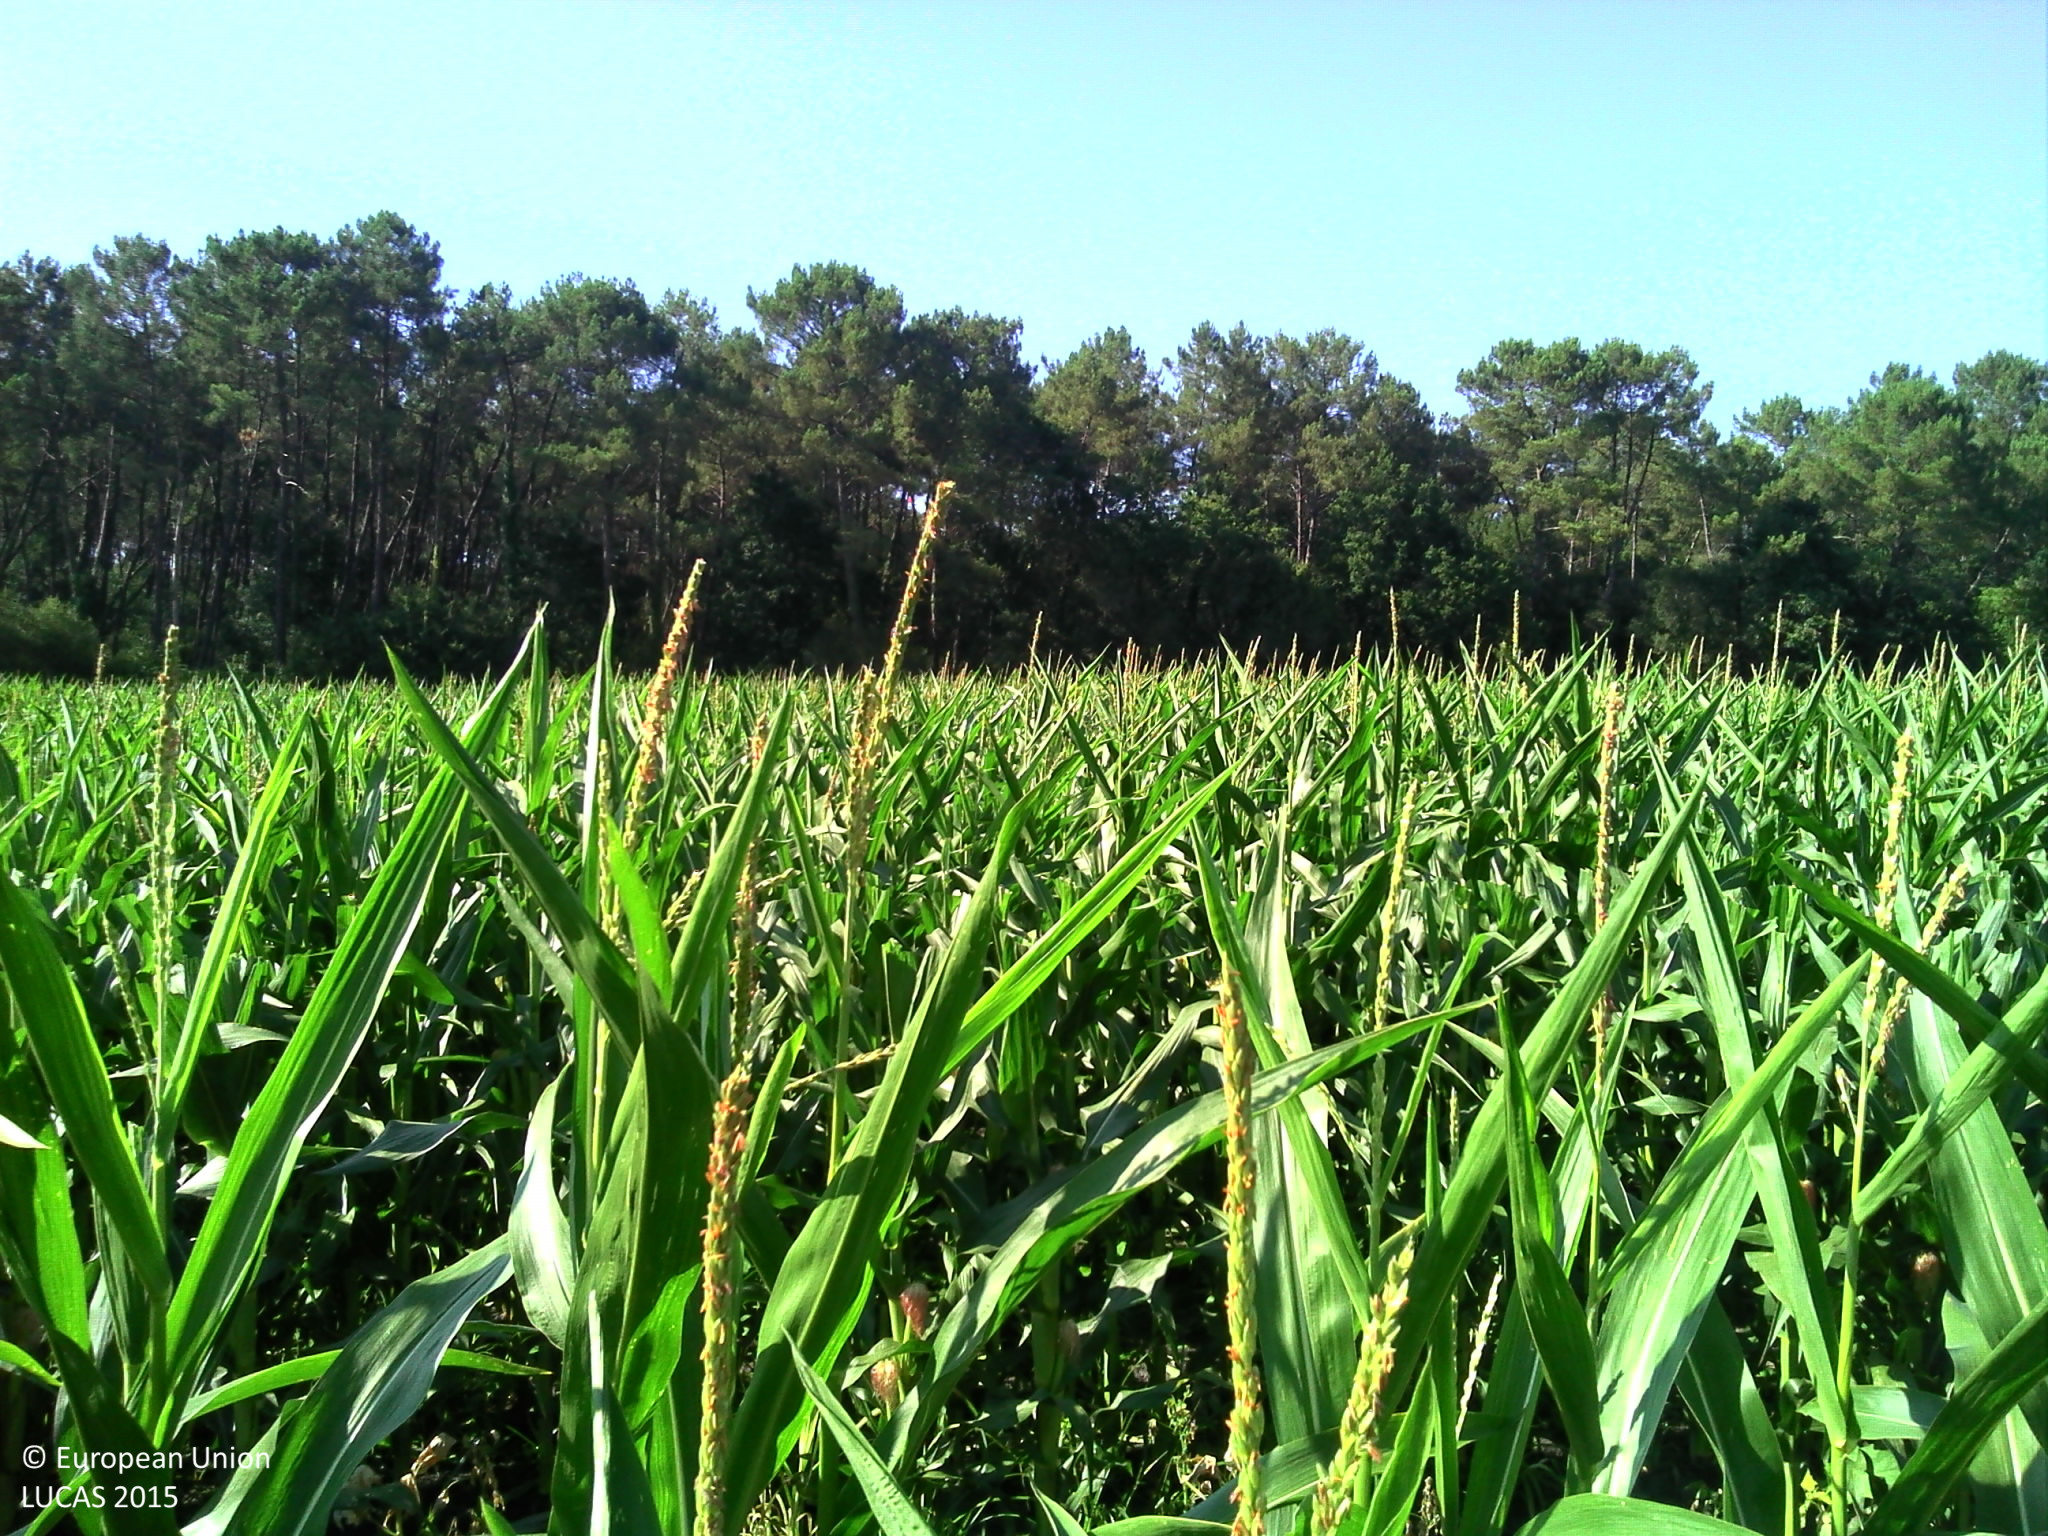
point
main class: Cropland
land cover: Maize
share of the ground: > 75 %
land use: Agriculture (excluding fallow land and kitchen gardens)
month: July
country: FR
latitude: 43.6882
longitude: -1.1948
